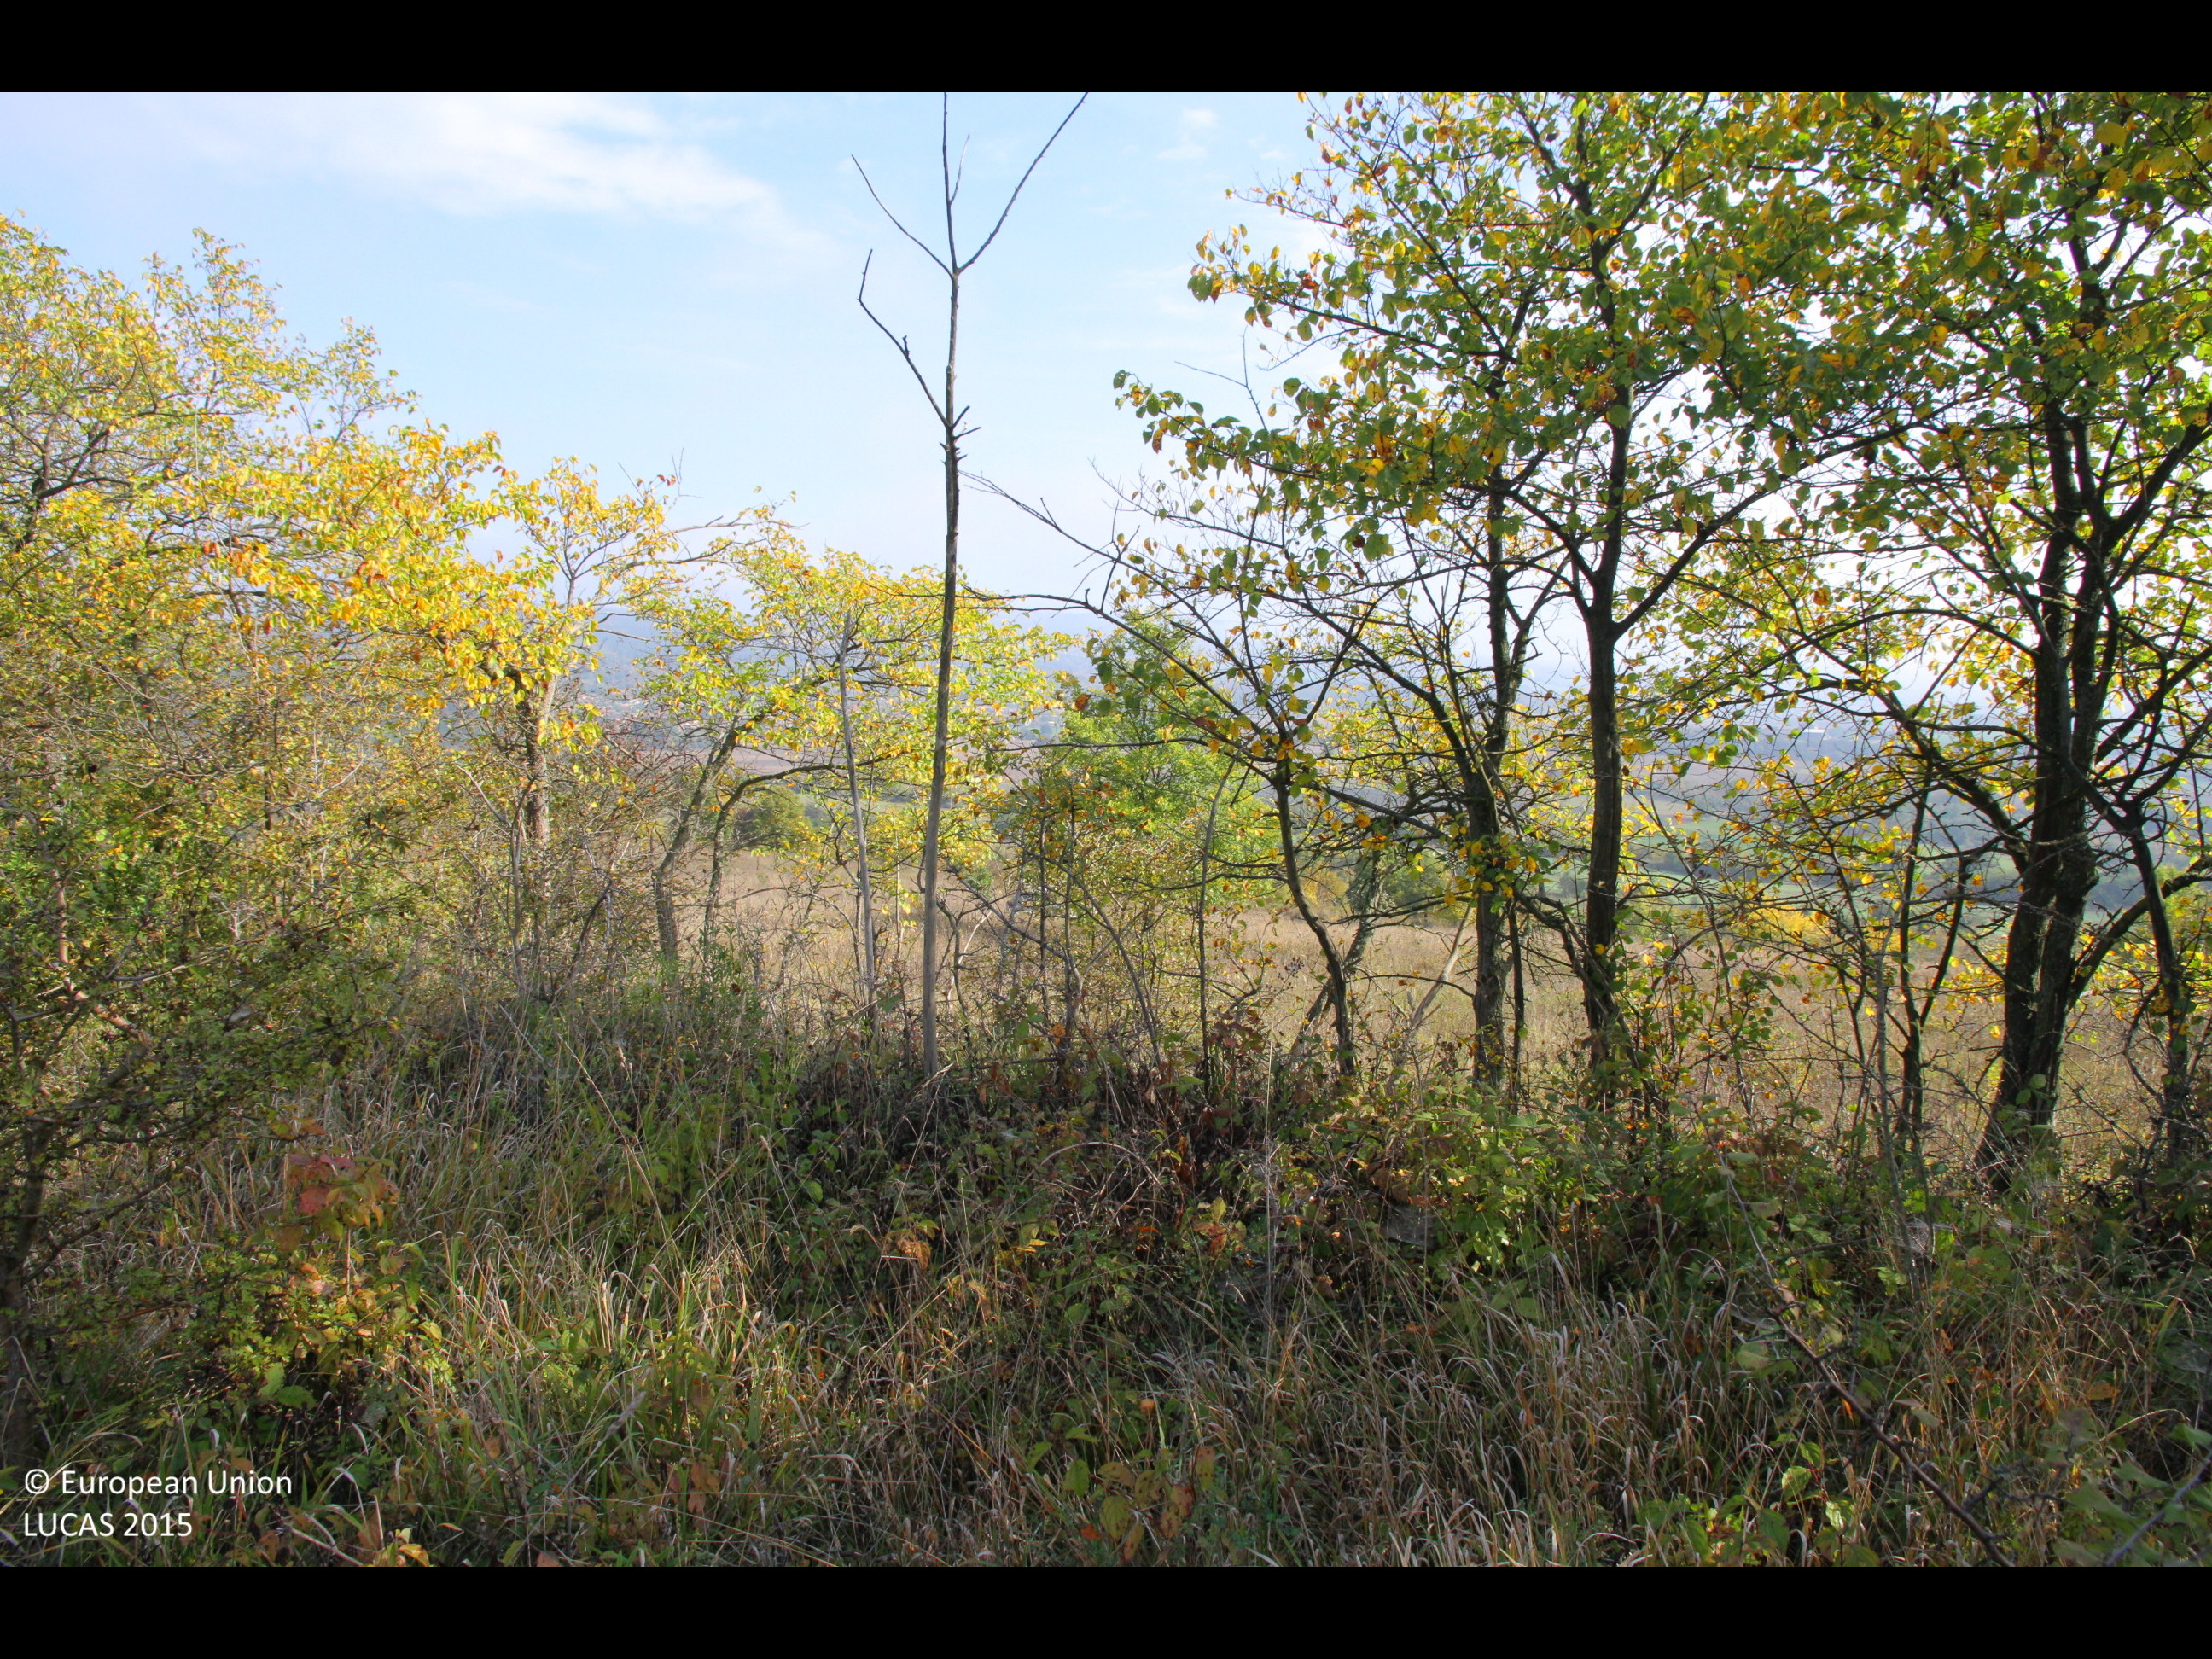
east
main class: Grassland
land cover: Grassland with sparse tree/shrub cover
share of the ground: > 75 %
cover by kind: herbaceous plants 85 %, shrubs 10 %, broadleaved forest trees 5 %
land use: Agriculture (excluding fallow land and kitchen gardens)
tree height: > 5 m
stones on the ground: < 10 %
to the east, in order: Grassland with sparse tree/shrub cover; Lines of trees; Grassland without tree/shrub cover; Tracks; Grassland with sparse tree/shrub cover
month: October
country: BG
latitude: 43.0659
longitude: 27.0976
